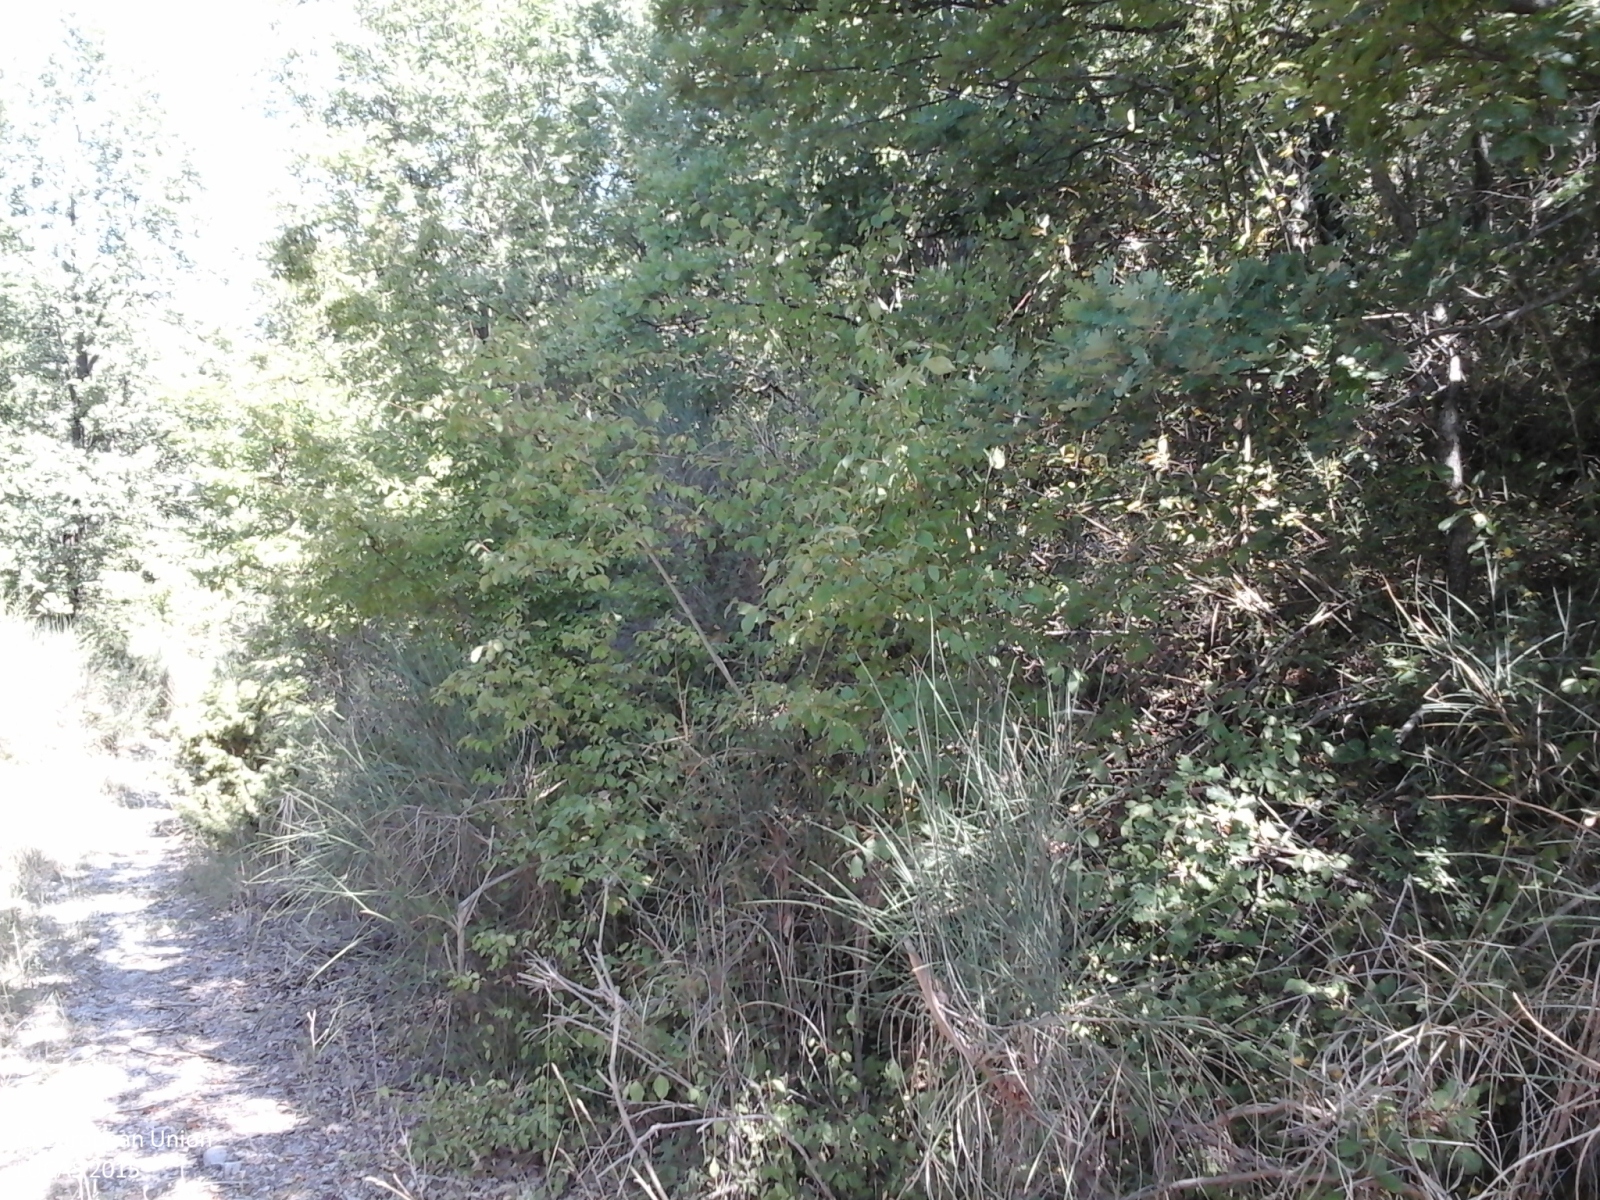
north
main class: Woodland
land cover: Broadleaved woodland
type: thermophilous deciduous forest
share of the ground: > 75 %
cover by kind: broadleaved forest trees 85 %, shrubs 10 %, herbaceous plants 5 %
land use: Forestry
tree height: > 5 m
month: September
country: IT
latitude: 41.6985
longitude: 14.2029
